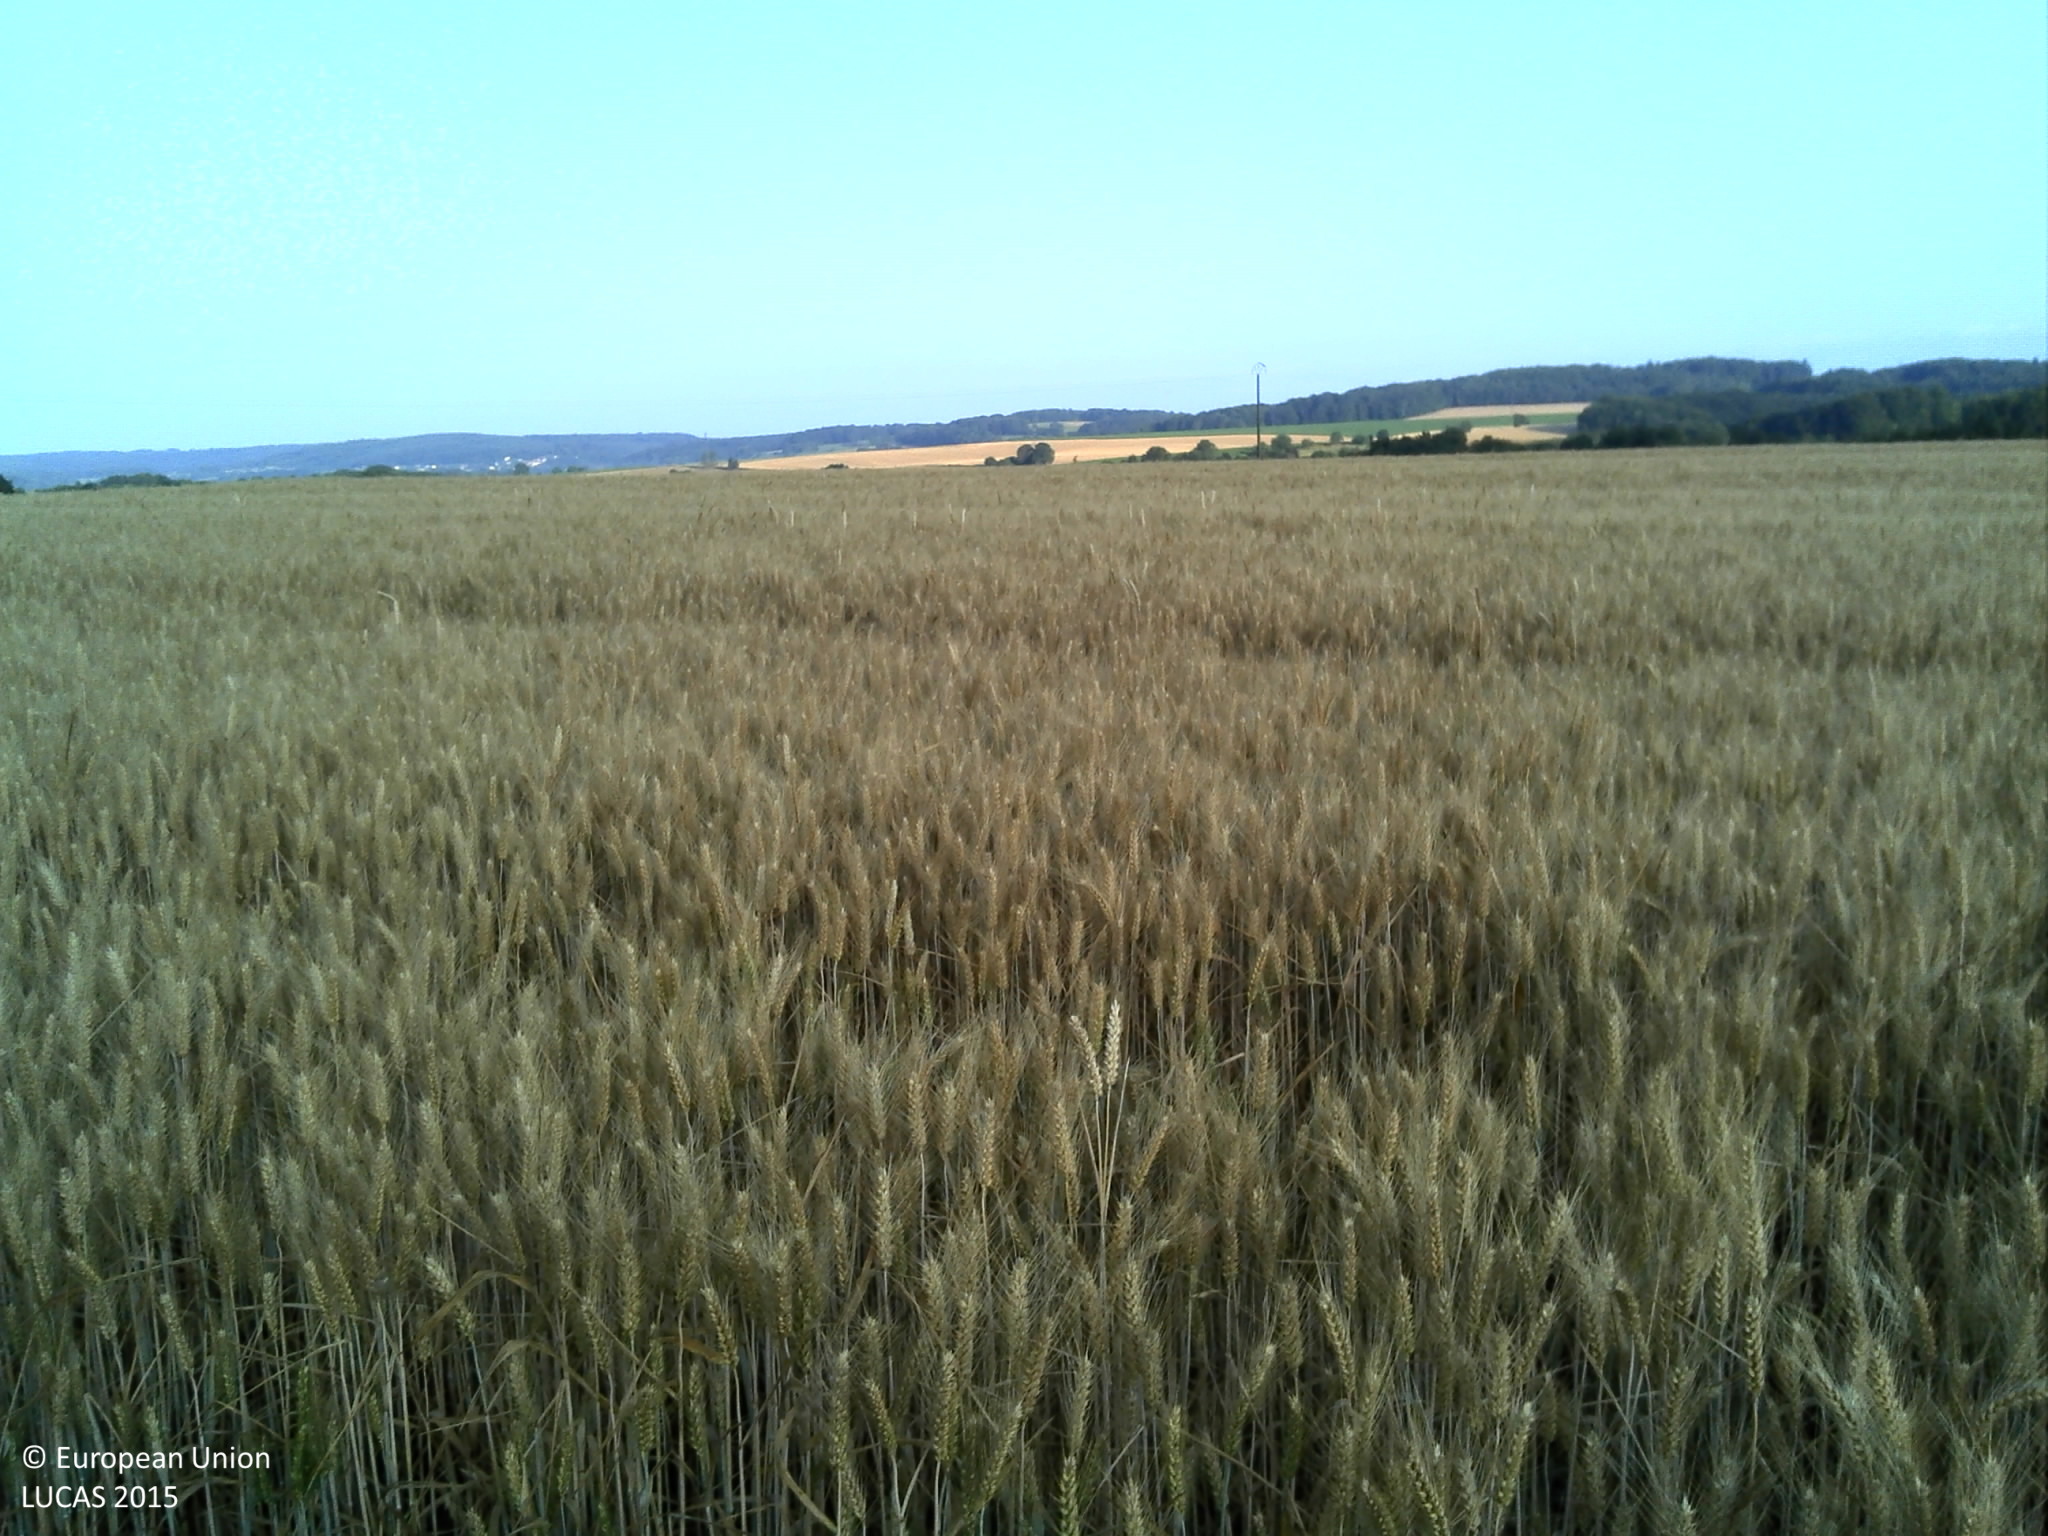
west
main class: Cropland
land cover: Durum wheat
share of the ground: > 75 %
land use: Agriculture (excluding fallow land and kitchen gardens)
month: July
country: FR
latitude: 48.1086
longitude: 6.3341
